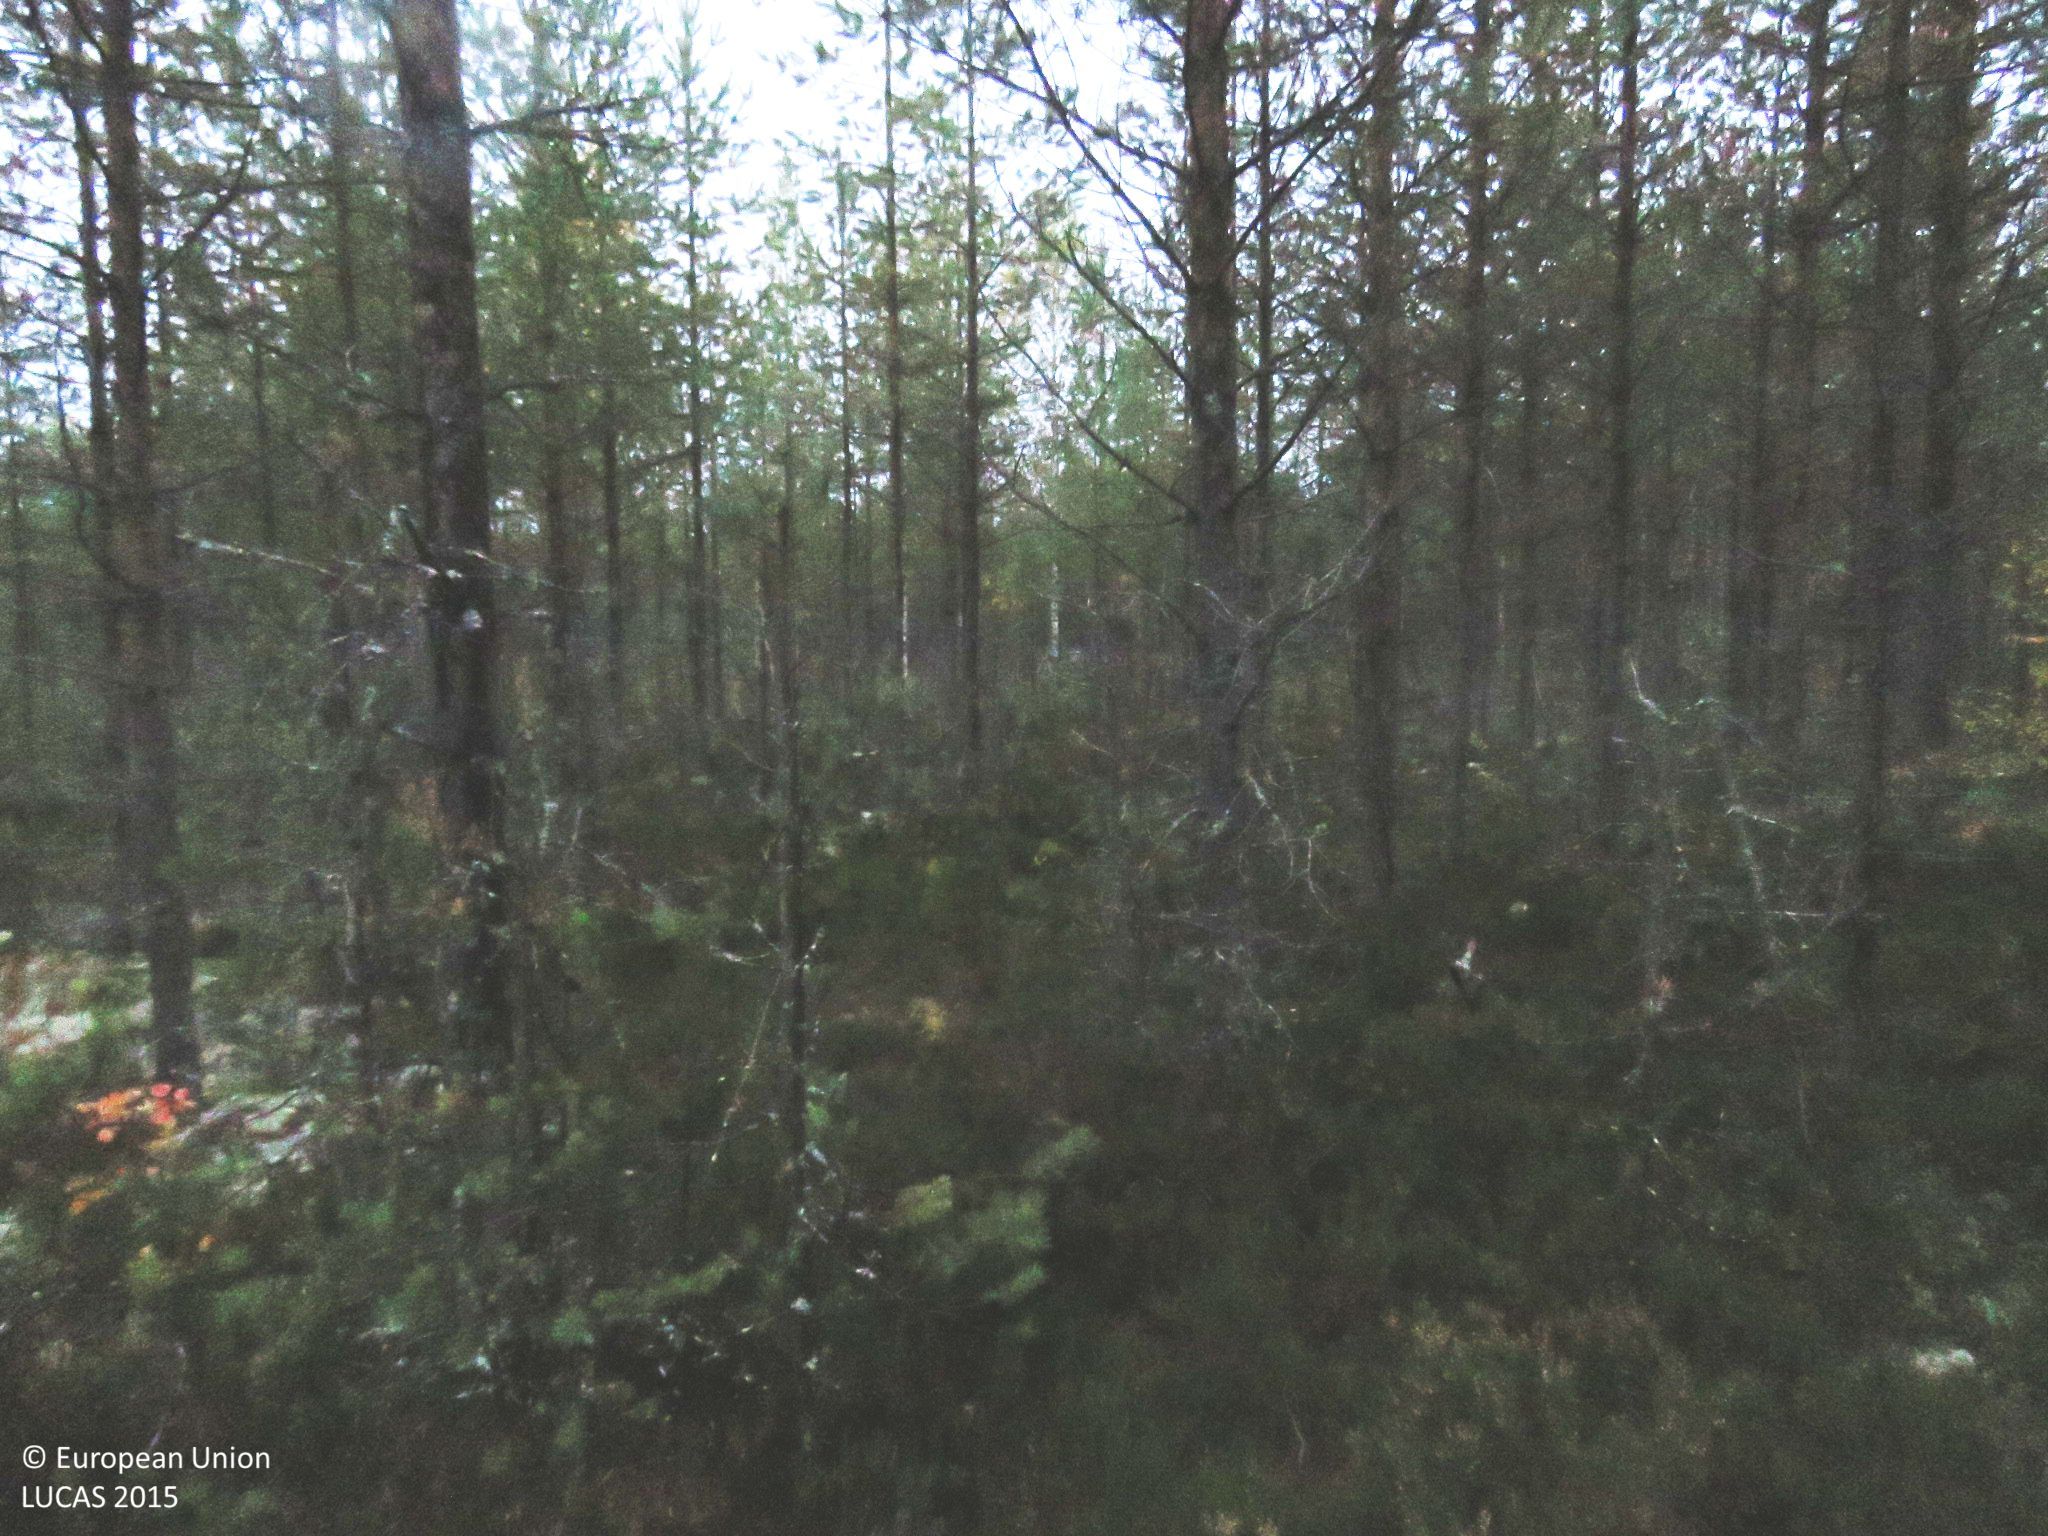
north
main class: Woodland
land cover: Pine dominated coniferous woodland
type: boreal forest
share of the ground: > 75 %
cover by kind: coniferous forest trees 65 %, shrubs 20 %, broadleaved forest trees 10 %, lichens and mosses 5 %
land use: Forestry
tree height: > 5 m
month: September
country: FI
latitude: 64.7955
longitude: 26.5922
